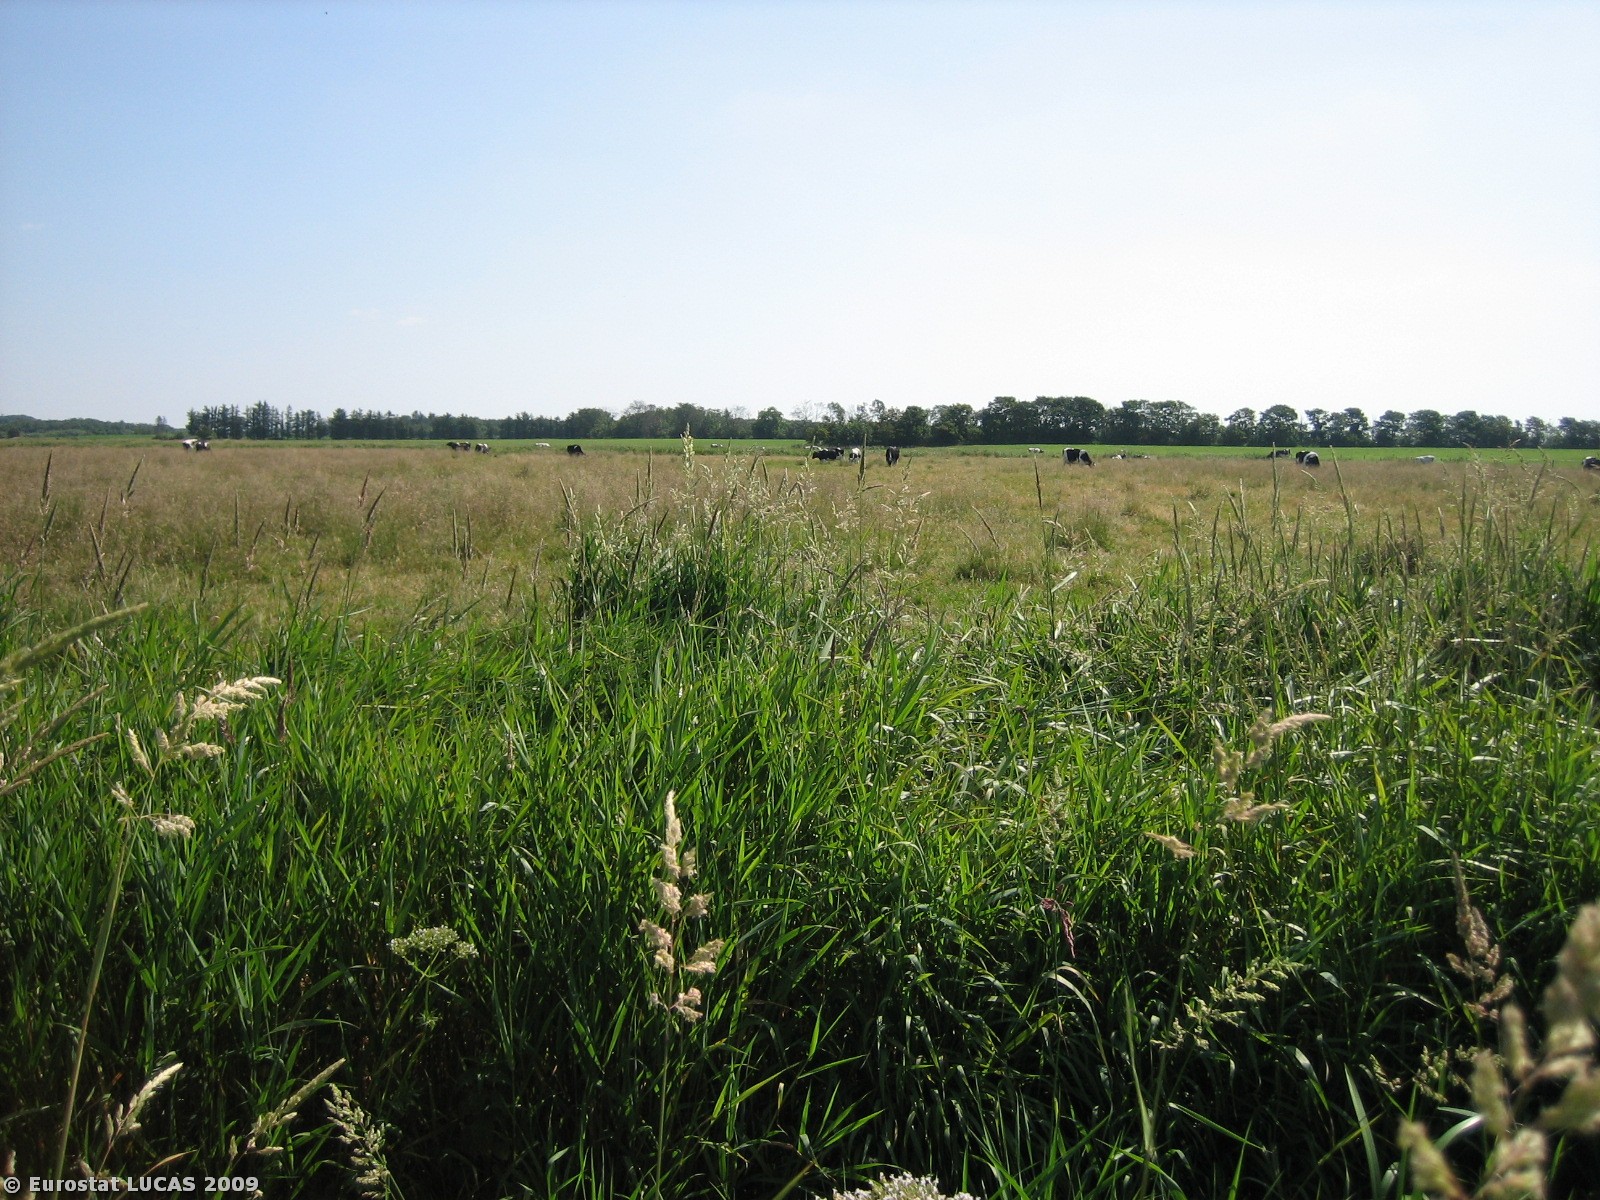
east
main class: Grassland
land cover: Grassland without tree/shrub cover
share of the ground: > 75 %
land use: Agriculture (excluding fallow land and kitchen gardens)
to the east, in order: Grassland without tree/shrub cover; Fences; Ditches and canals; Grassland without tree/shrub cover; Ditches and canals; Fences; Grassland without tree/shrub cover; Fences; Ditches and canals; Grassland without tree/shrub cover; Broadleaved woodland; Barley
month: July
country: DK
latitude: 55.4093
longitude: 8.8165
